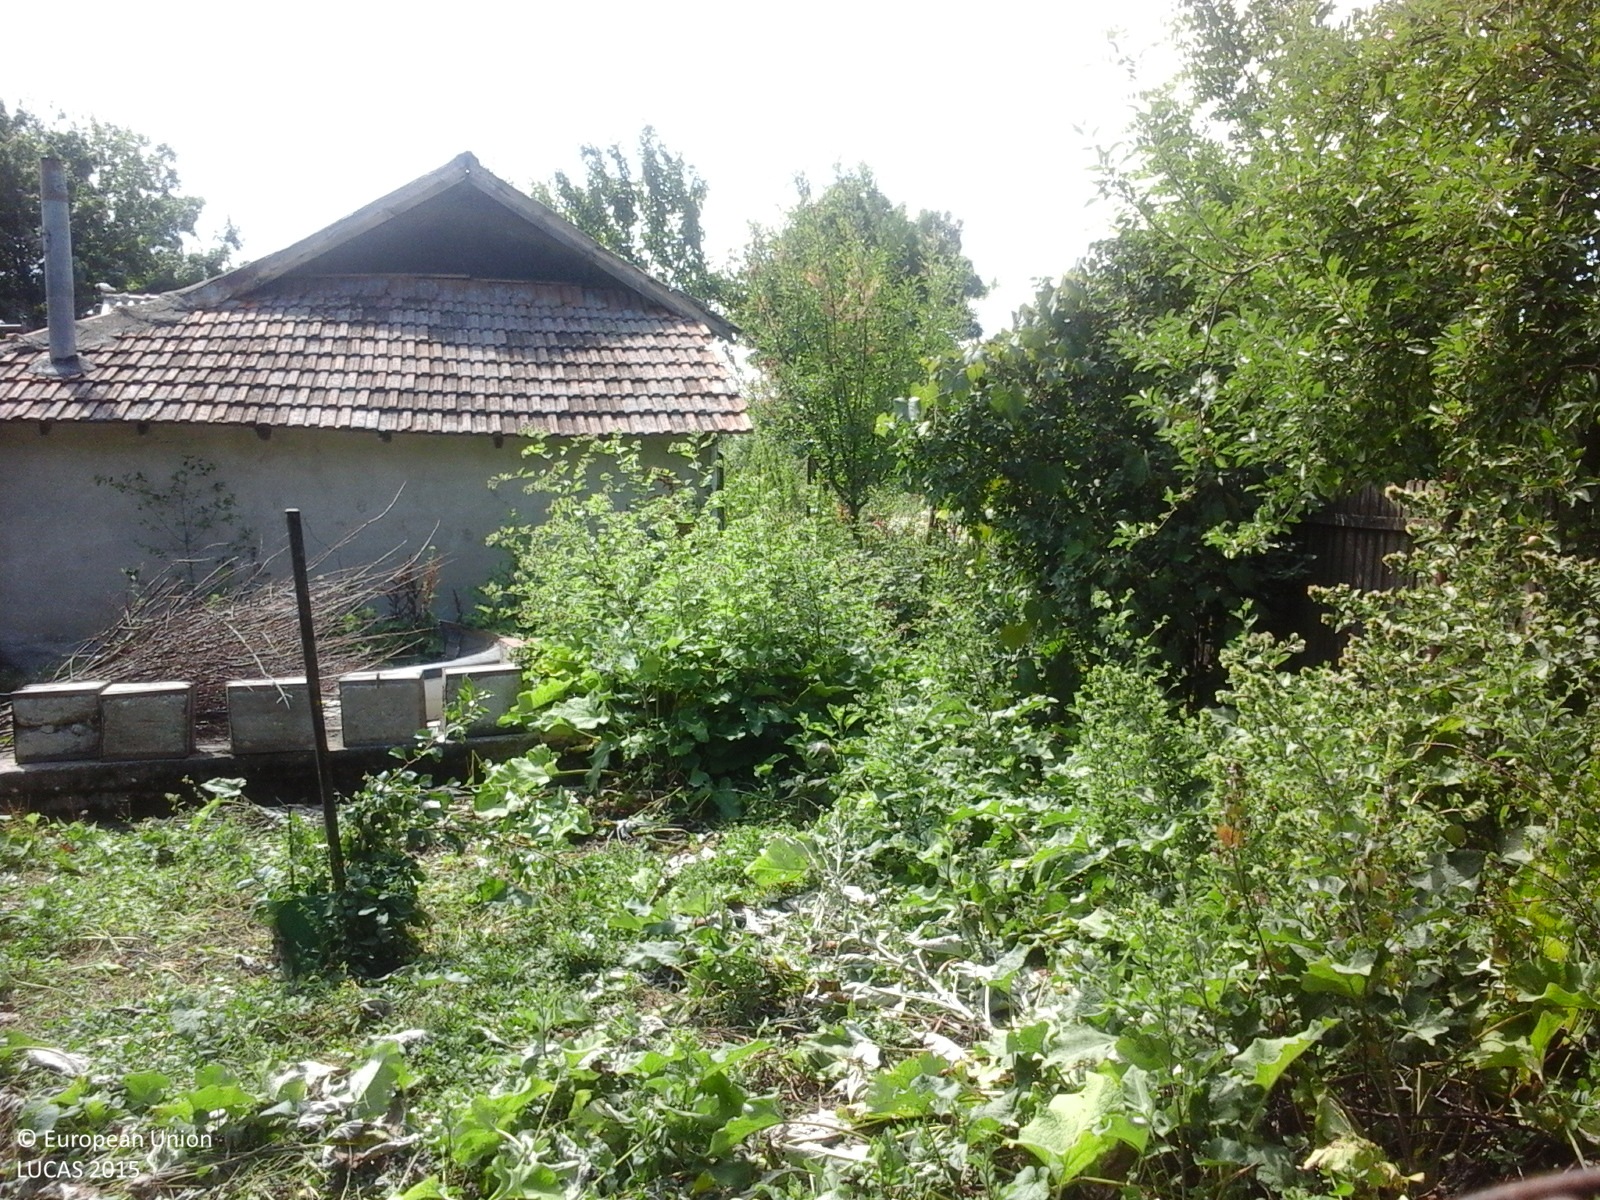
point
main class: Grassland
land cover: Grassland with sparse tree/shrub cover
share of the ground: > 75 %
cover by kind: herbaceous plants 95 %, broadleaved forest trees 5 %
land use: Residential
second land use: Agriculture (excluding fallow land and kitchen gardens)
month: July
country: RO
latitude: 44.3721
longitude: 25.3603
